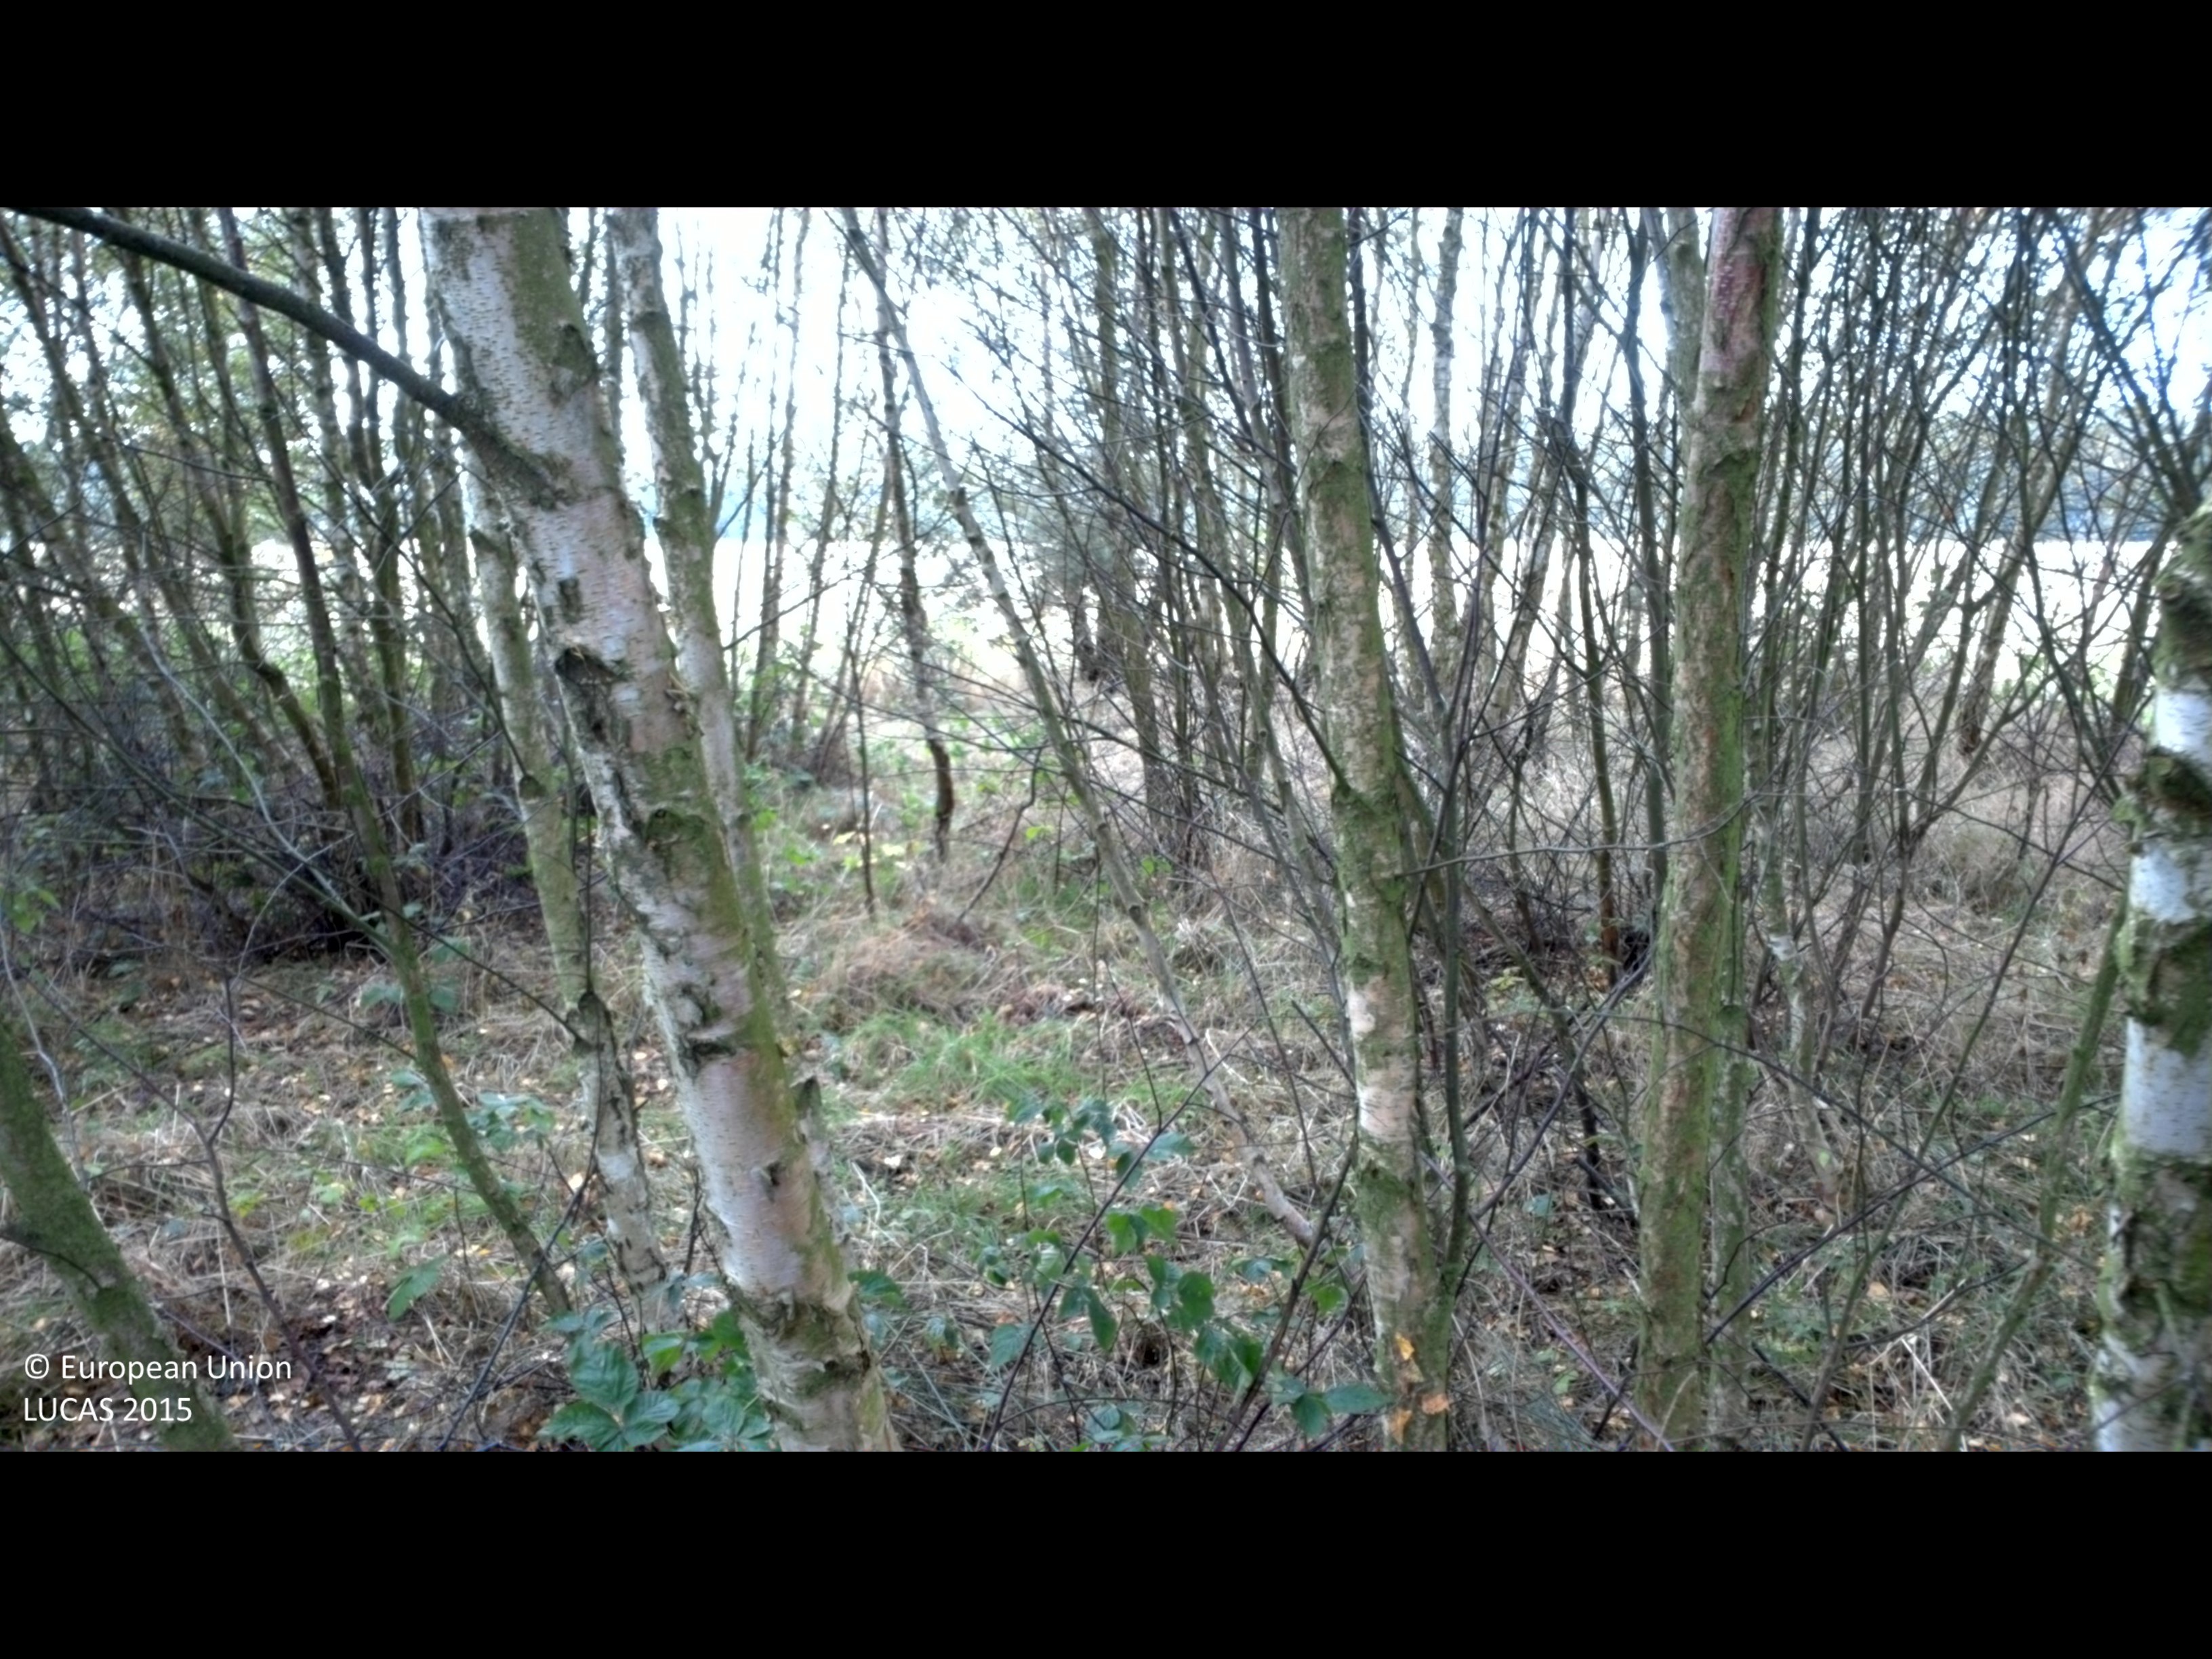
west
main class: Woodland
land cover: Broadleaved woodland
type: hemiboreal forest and nemoral coniferous forest and mixed broadleaved-coniferous forest
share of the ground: > 75 %
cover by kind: broadleaved forest trees 85 %, shrubs 10 %, herbaceous plants 5 %
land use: Agriculture (excluding fallow land and kitchen gardens)
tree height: < 5 m
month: September
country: SE
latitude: 55.9862
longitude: 14.4062
